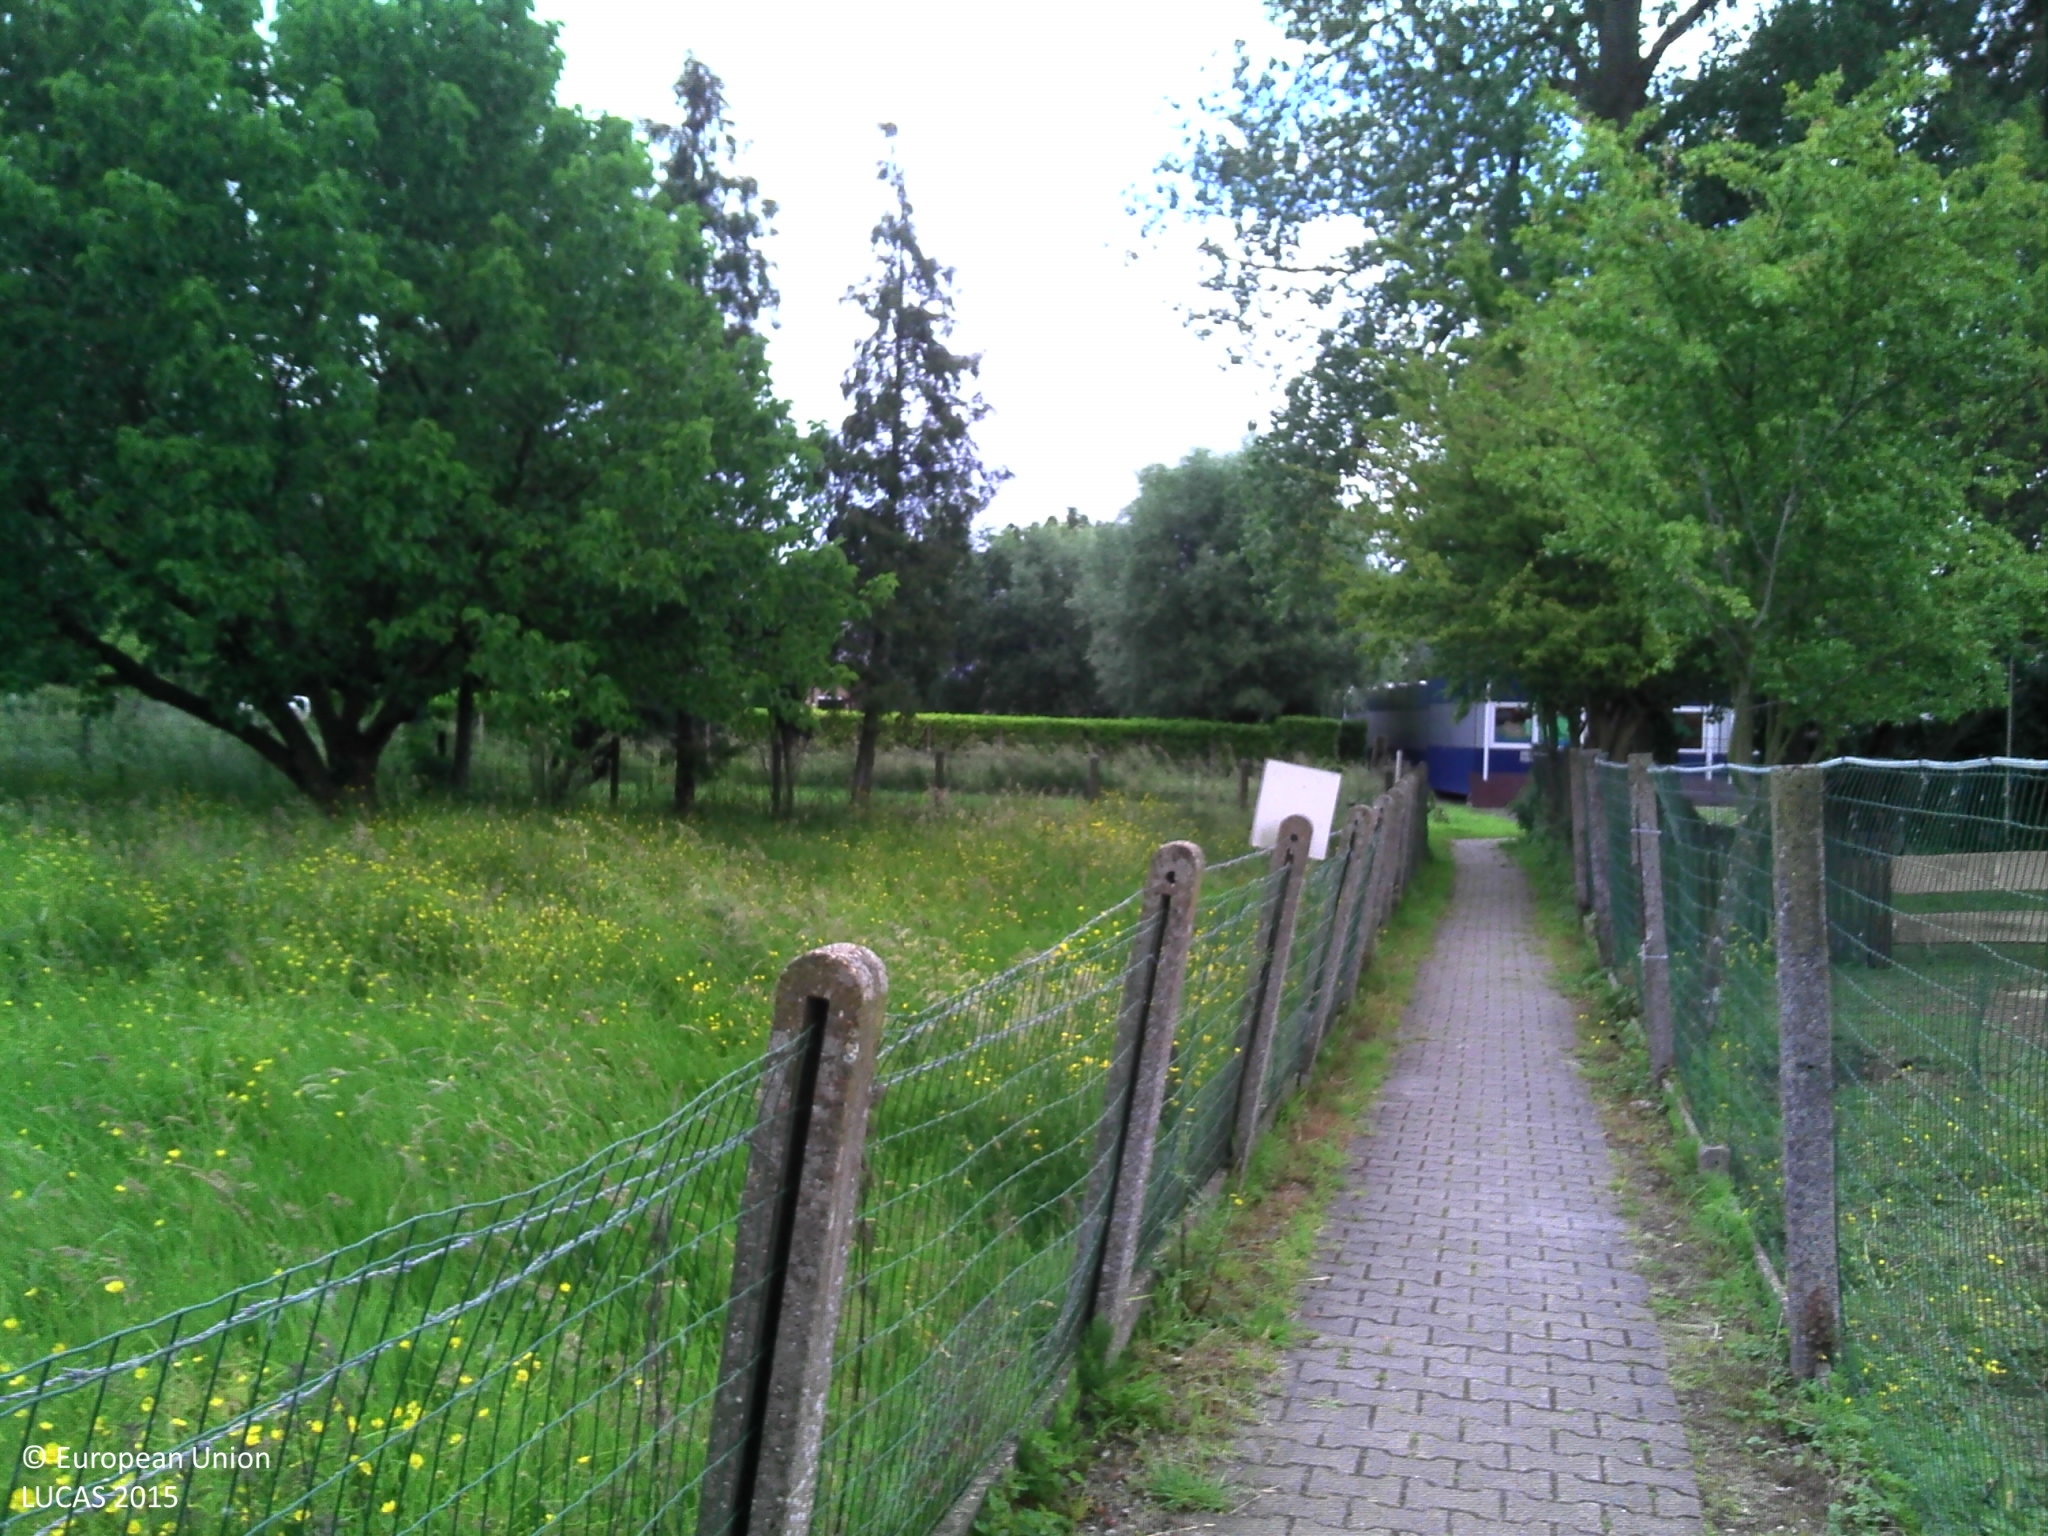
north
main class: Grassland
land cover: Grassland with sparse tree/shrub cover
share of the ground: > 75 %
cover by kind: herbaceous plants 95 %, broadleaved forest trees 5 %
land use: Residential
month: June
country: BE
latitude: 50.9653
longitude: 4.0281
